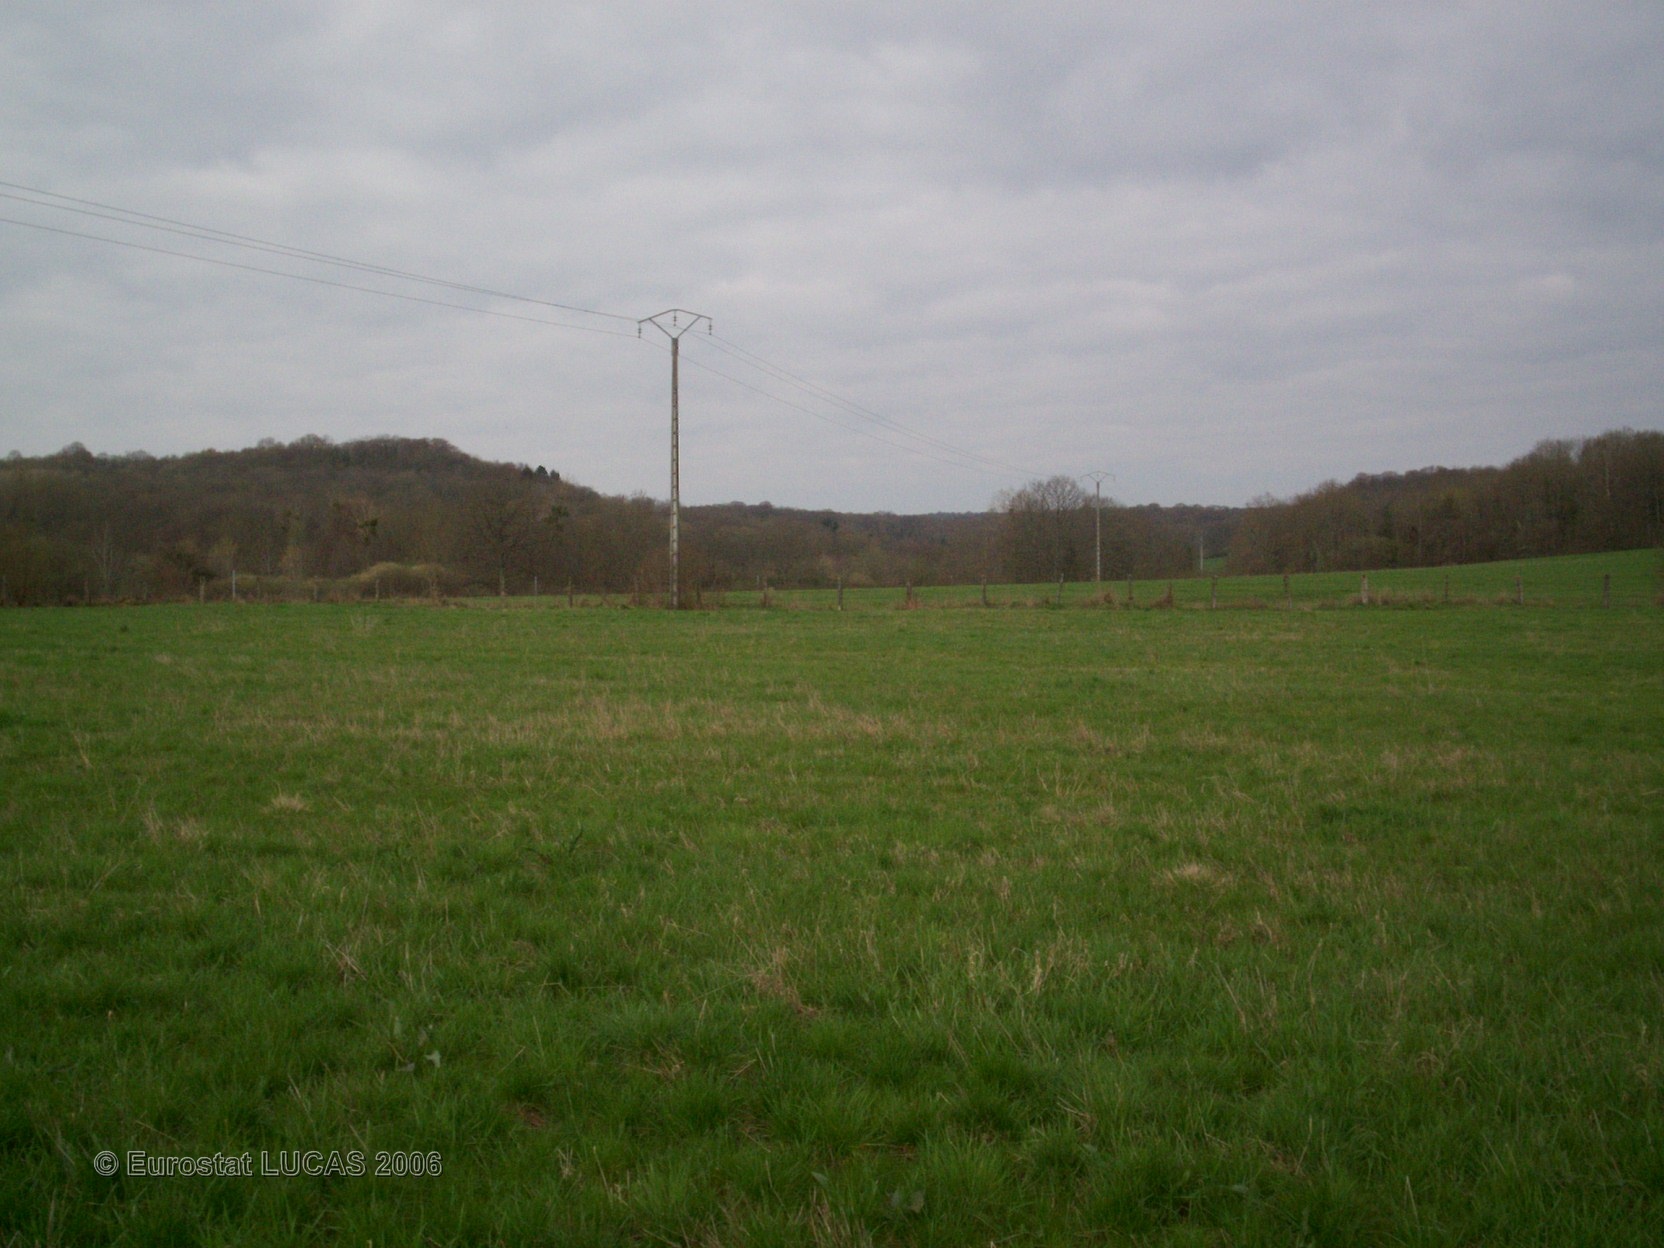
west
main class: Grassland
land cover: Grassland without tree/shrub cover
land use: Agriculture (excluding fallow land and kitchen gardens)
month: April
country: FR
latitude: 47.9599
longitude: 5.2722
